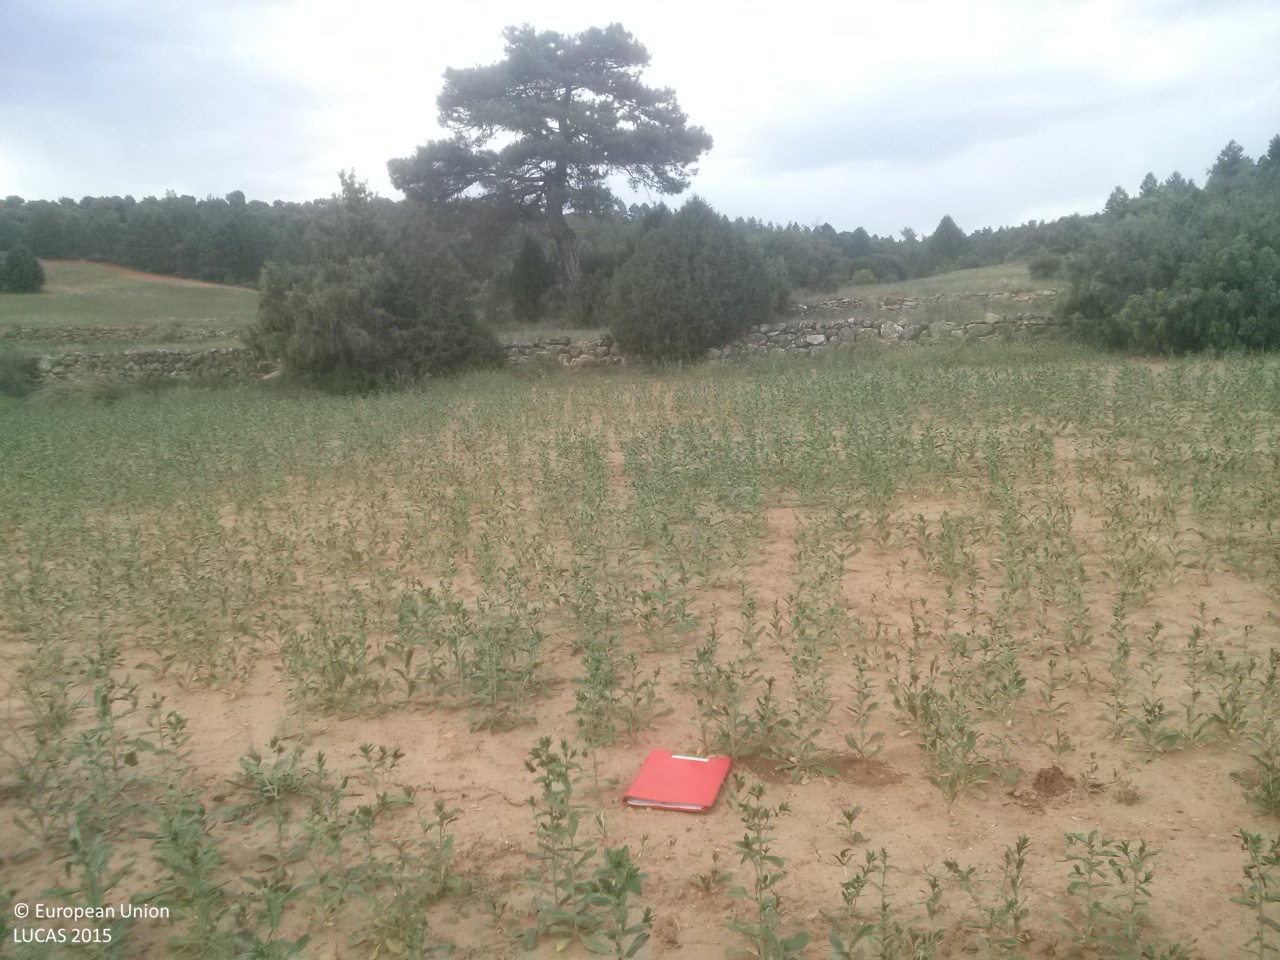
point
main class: Cropland
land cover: Other fibre and oleaginous crops
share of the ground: > 75 %
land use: Agriculture (excluding fallow land and kitchen gardens)
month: June
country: ES
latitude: 39.9629
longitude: -1.7297
